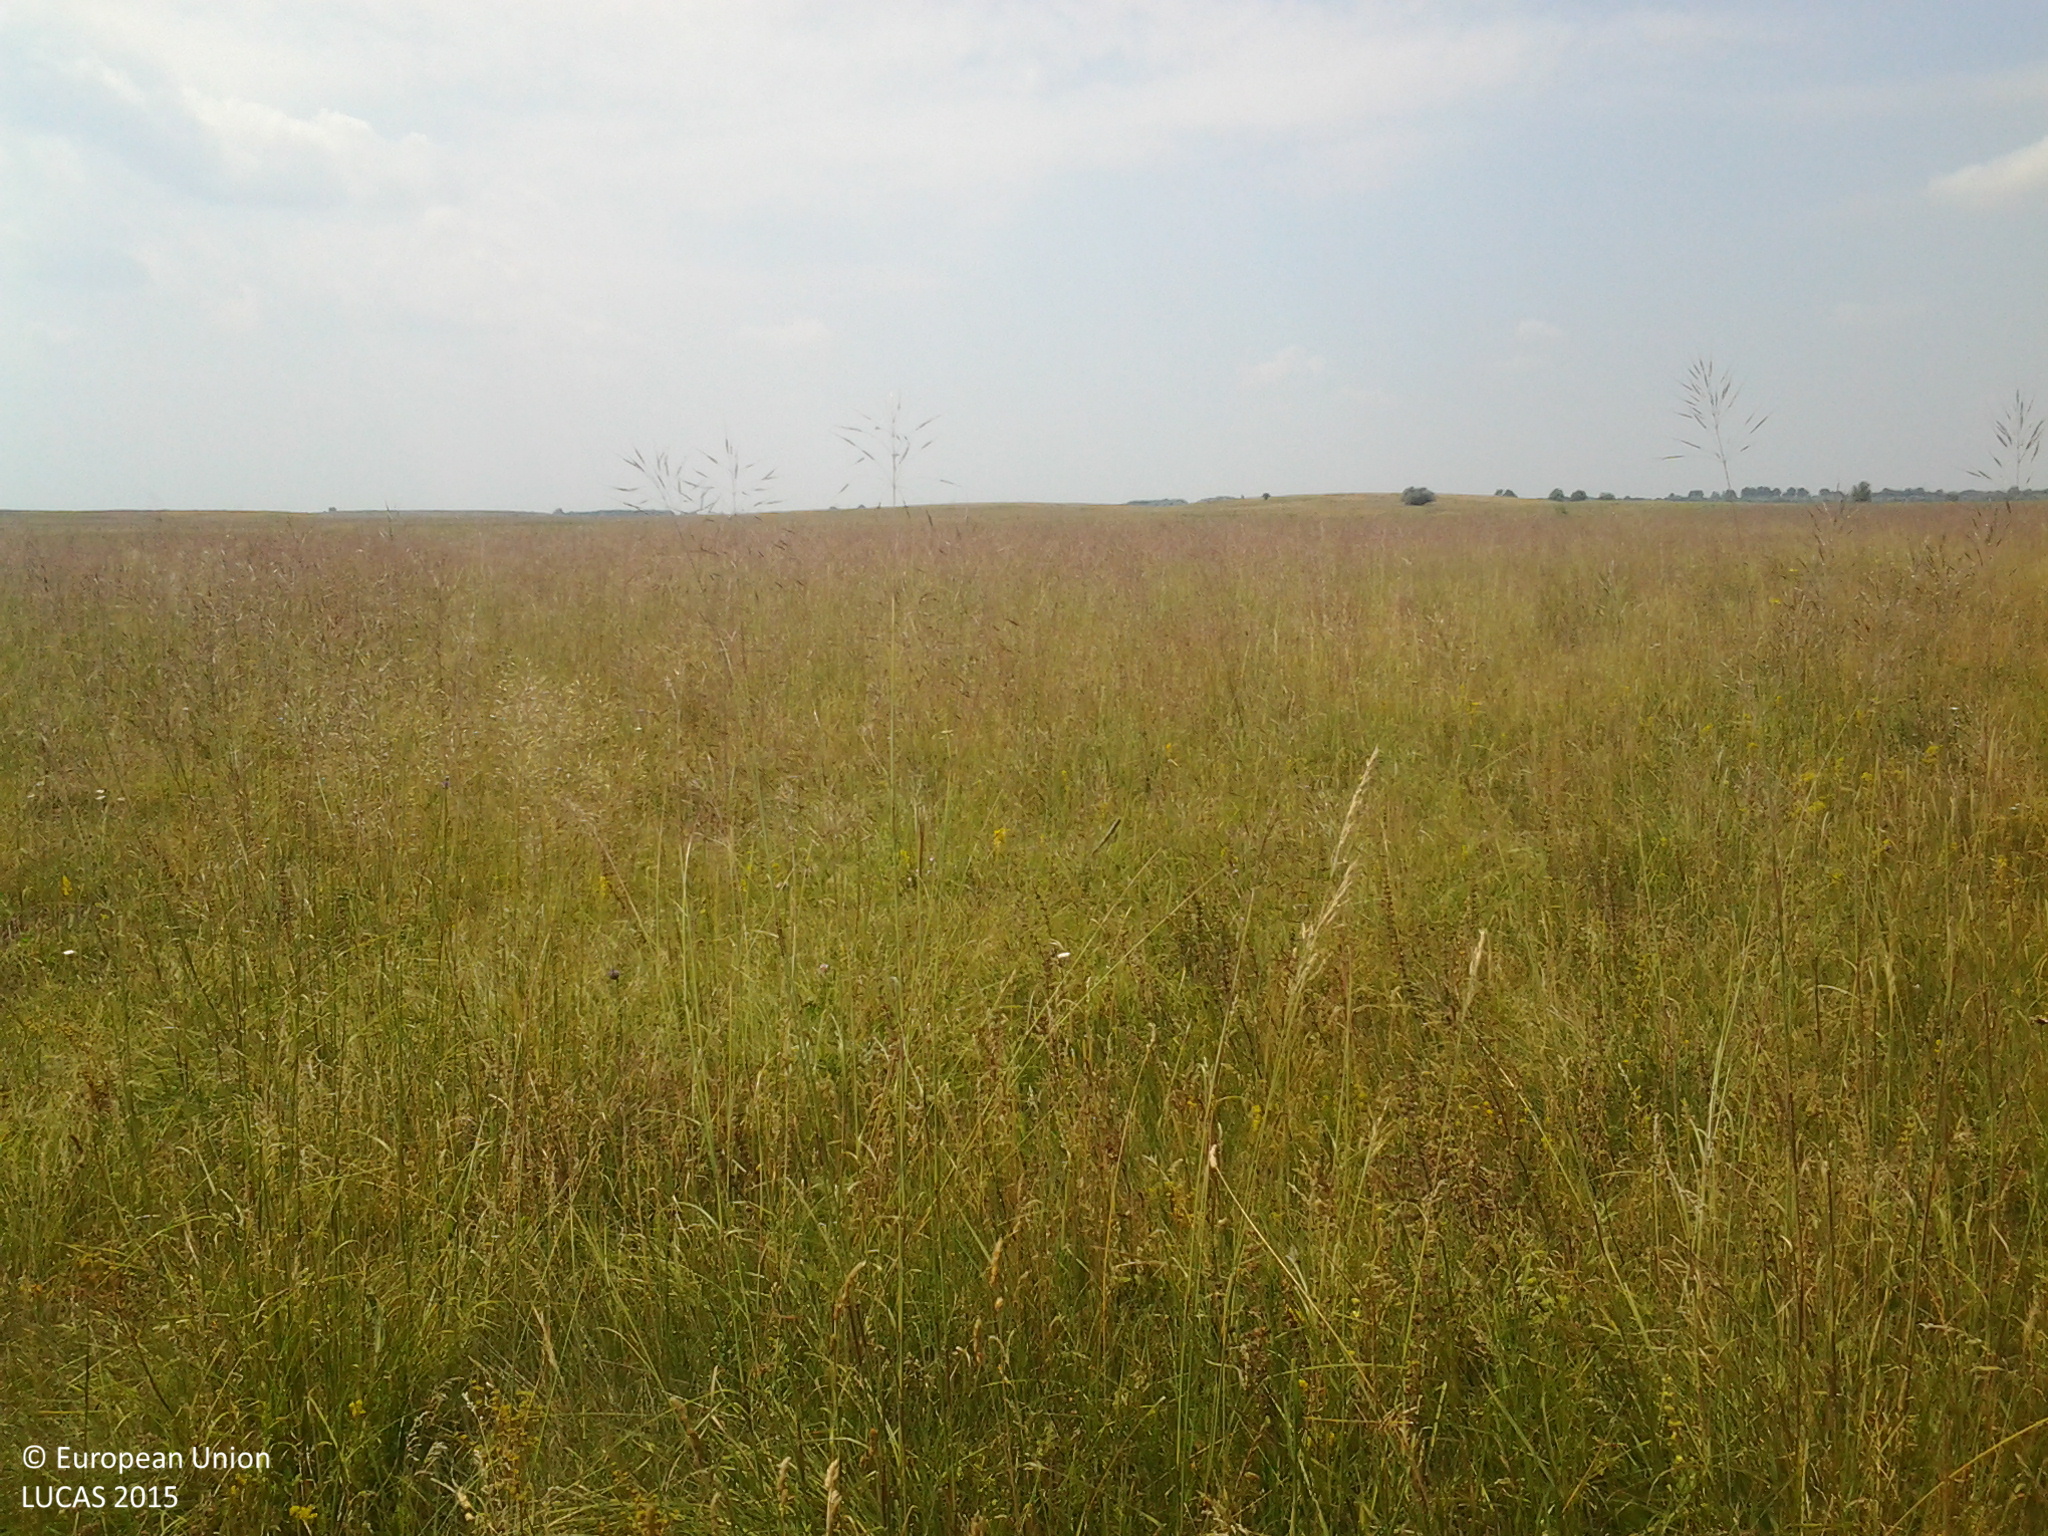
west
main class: Grassland
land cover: Grassland without tree/shrub cover
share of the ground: > 75 %
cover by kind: herbaceous plants 100 %
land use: Semi-natural and natural areas not in use
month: July
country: HU
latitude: 47.1089
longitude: 19.2556
